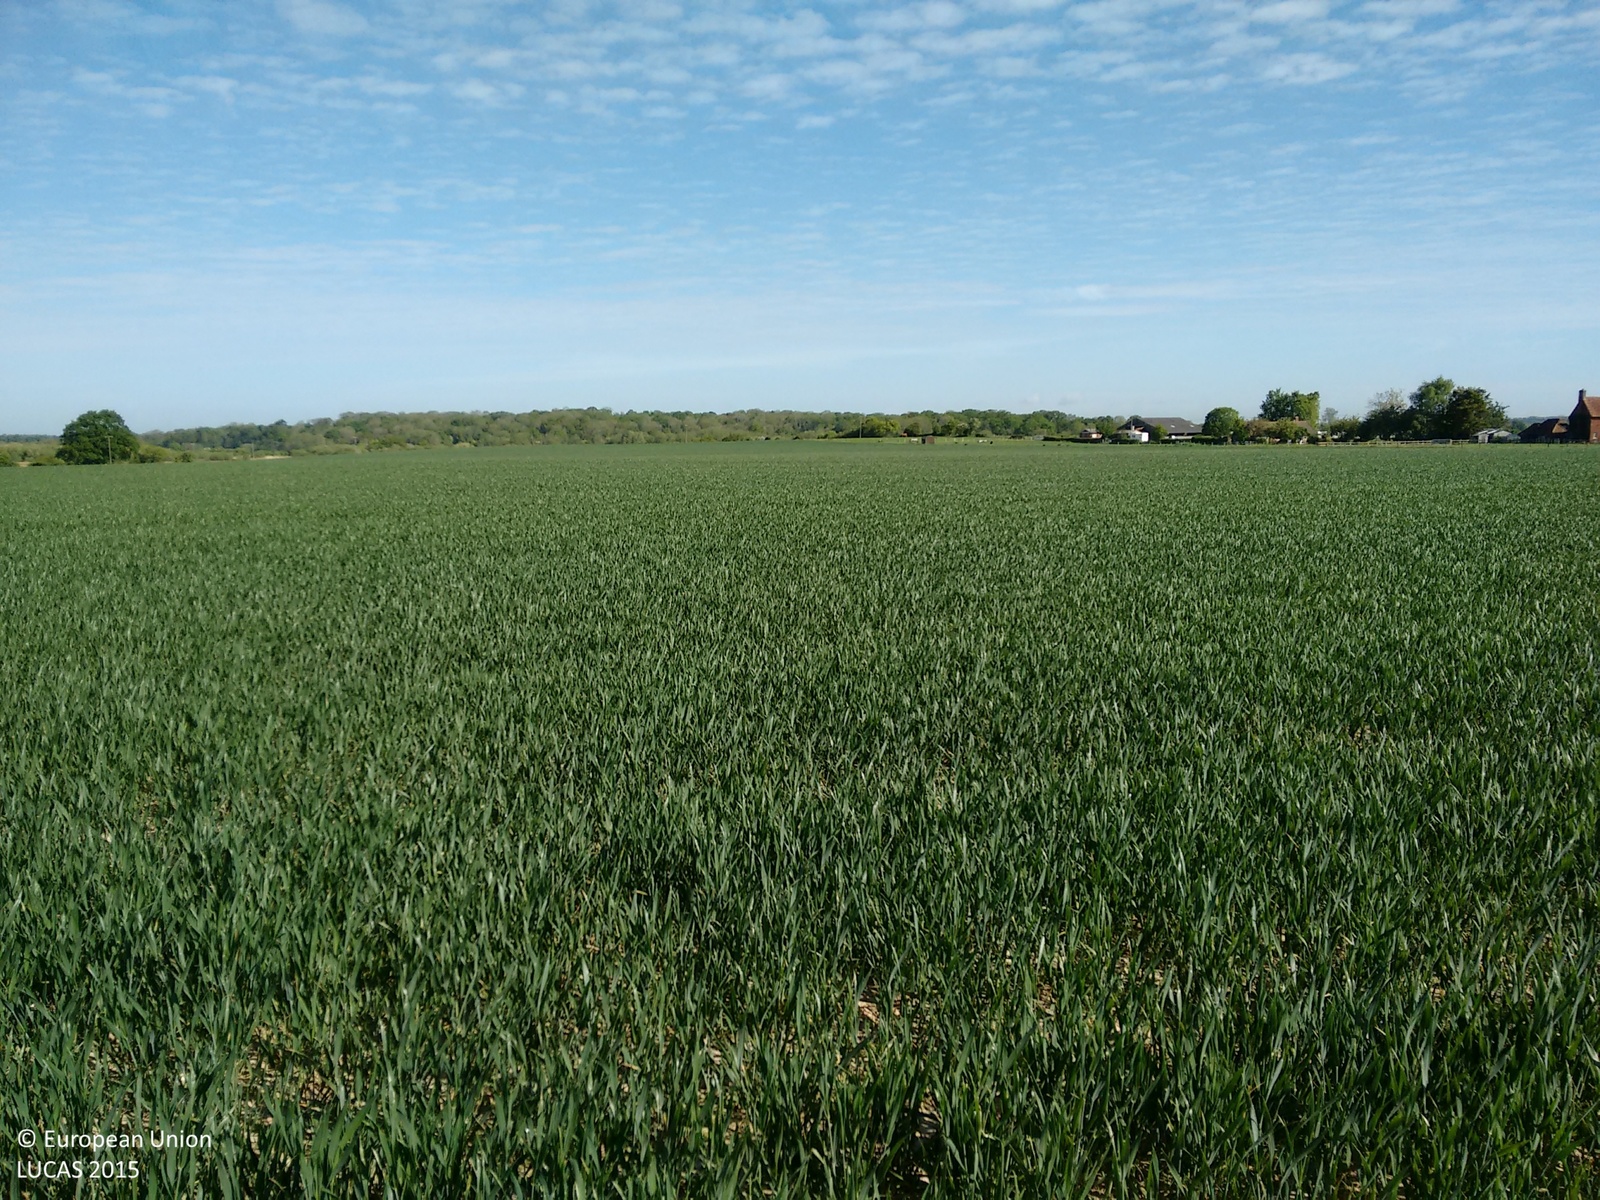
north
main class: Cropland
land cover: Common wheat
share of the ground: 50 - 75 %
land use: Agriculture (excluding fallow land and kitchen gardens)
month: May
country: GB
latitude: 51.2826
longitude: -1.0126
